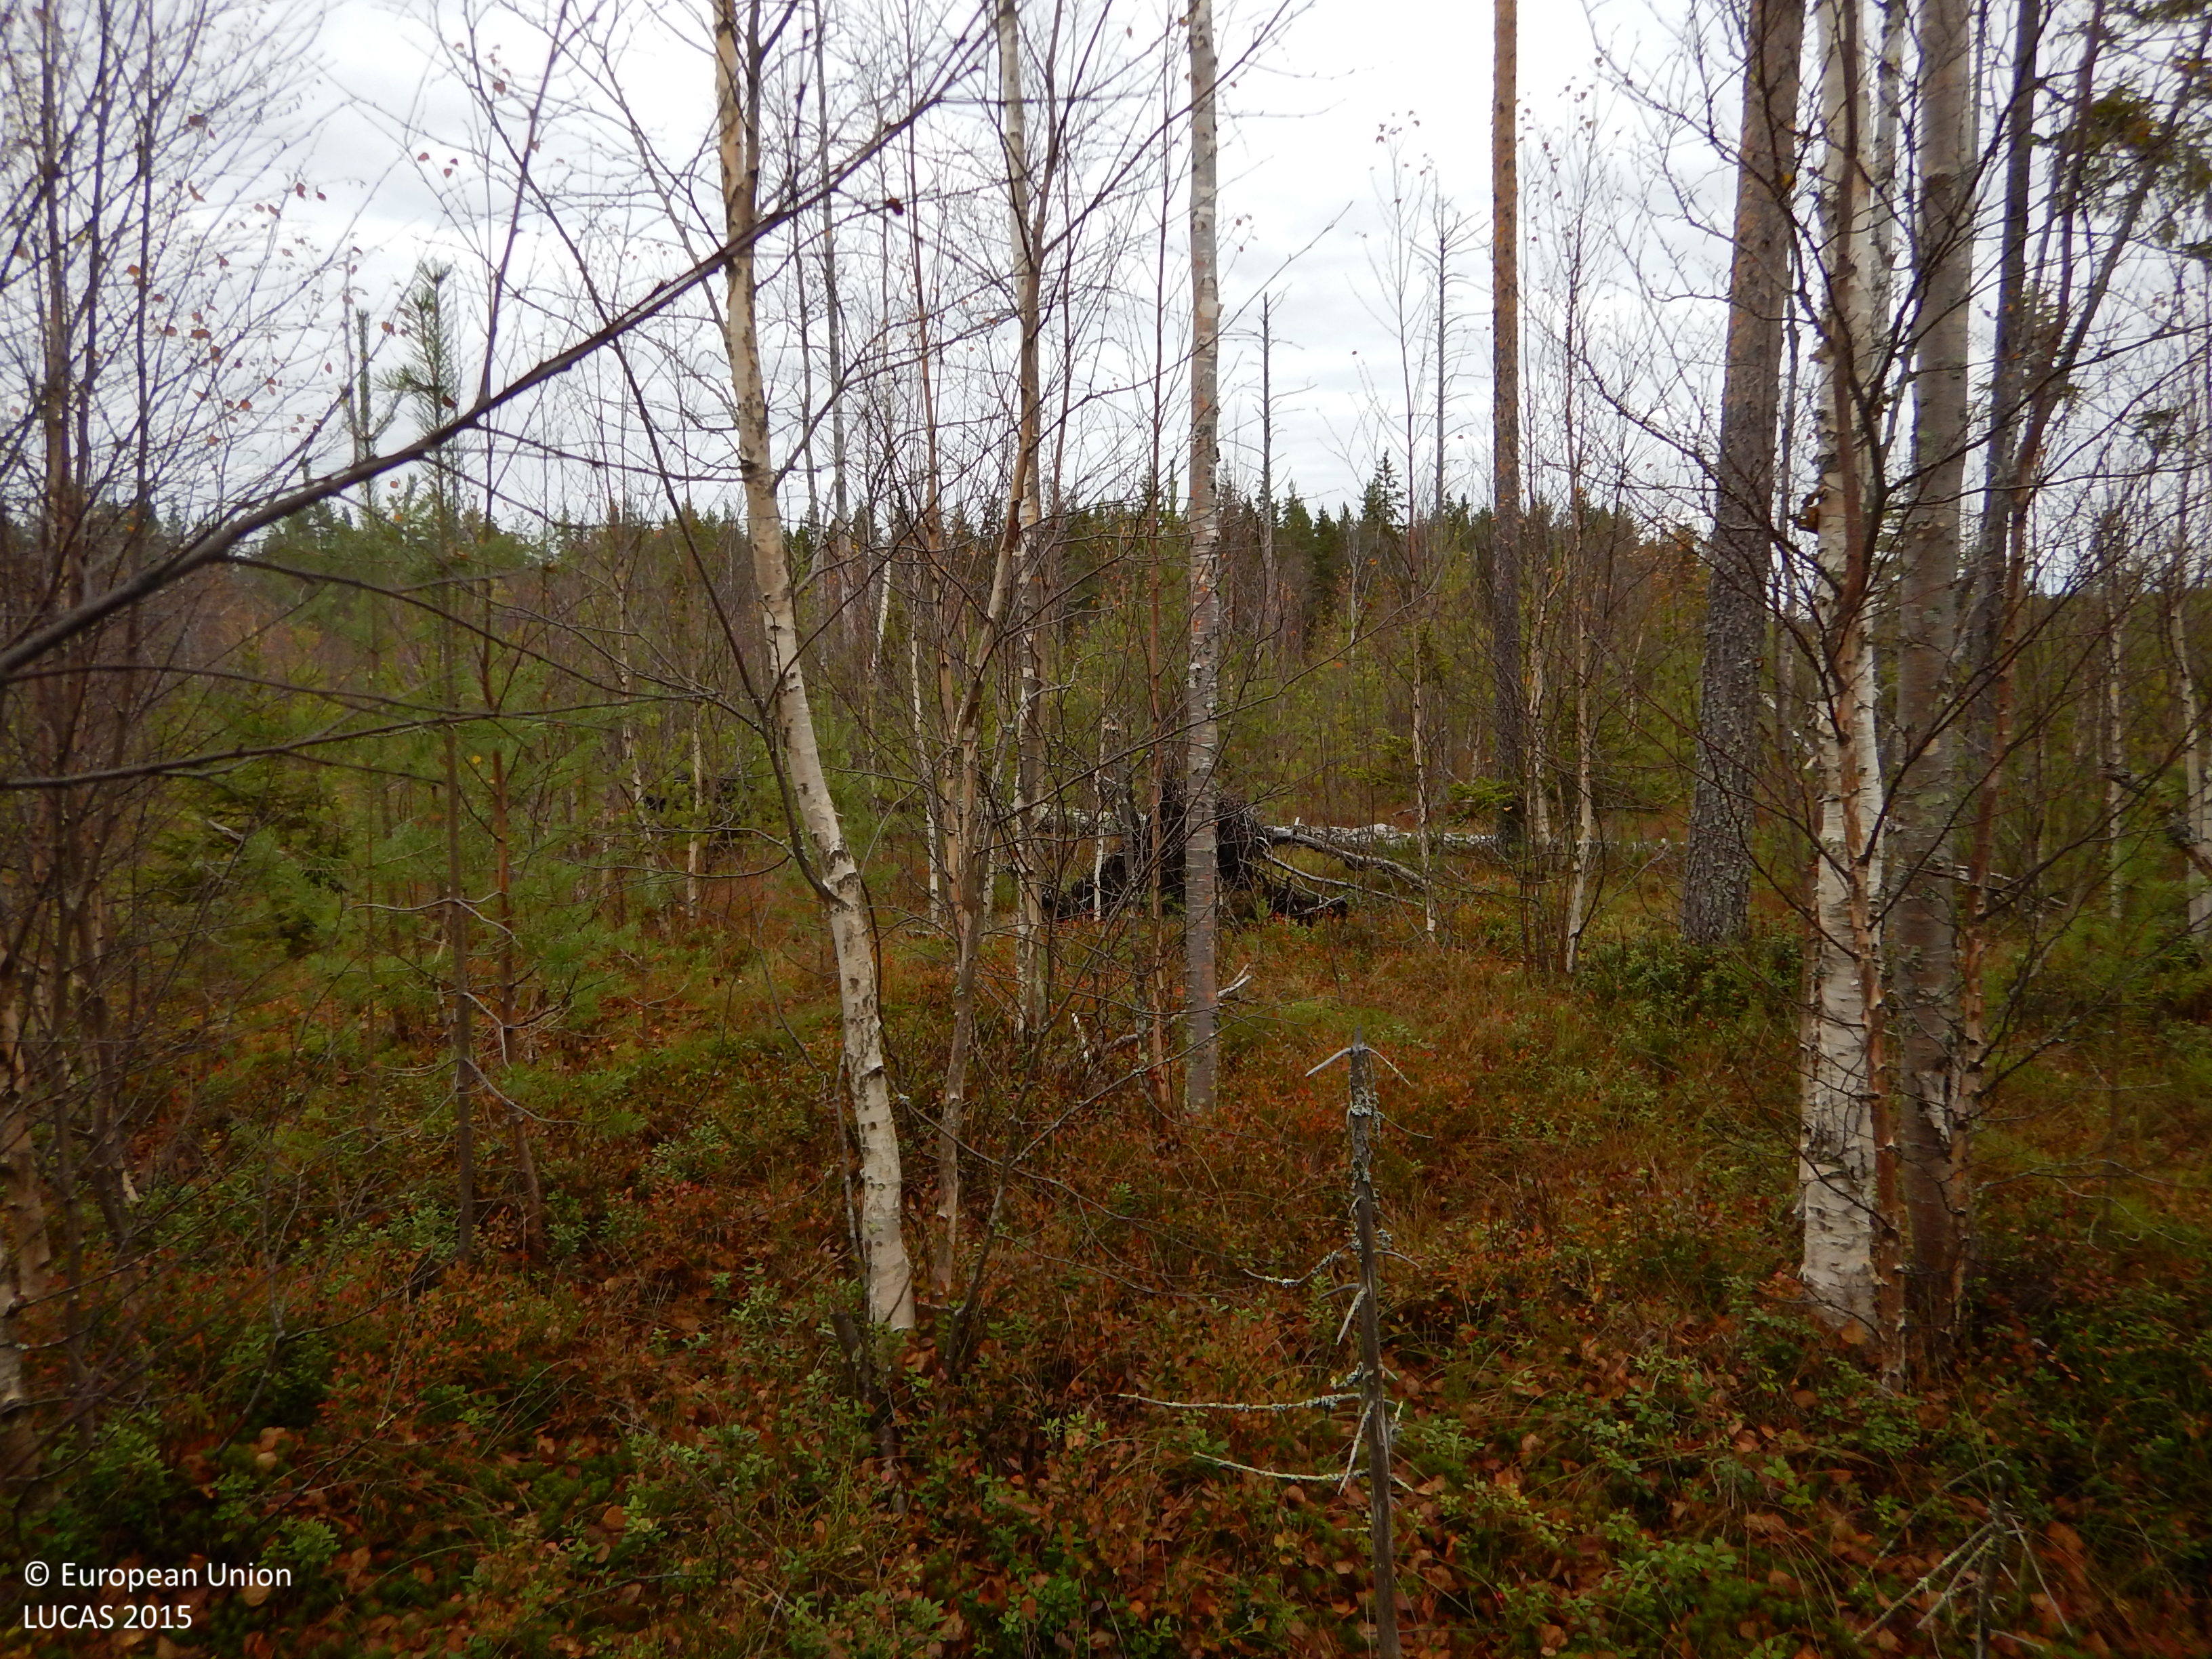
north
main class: Woodland
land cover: Other mixed woodland
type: boreal forest
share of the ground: 50 - 75 %
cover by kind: coniferous forest trees 30 %, broadleaved forest trees 20 %, shrubs 20 %, lichens and mosses 20 %, herbaceous plants 10 %
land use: Forestry
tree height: < 5 m
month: October
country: SE
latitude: 64.9558
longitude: 21.1348
